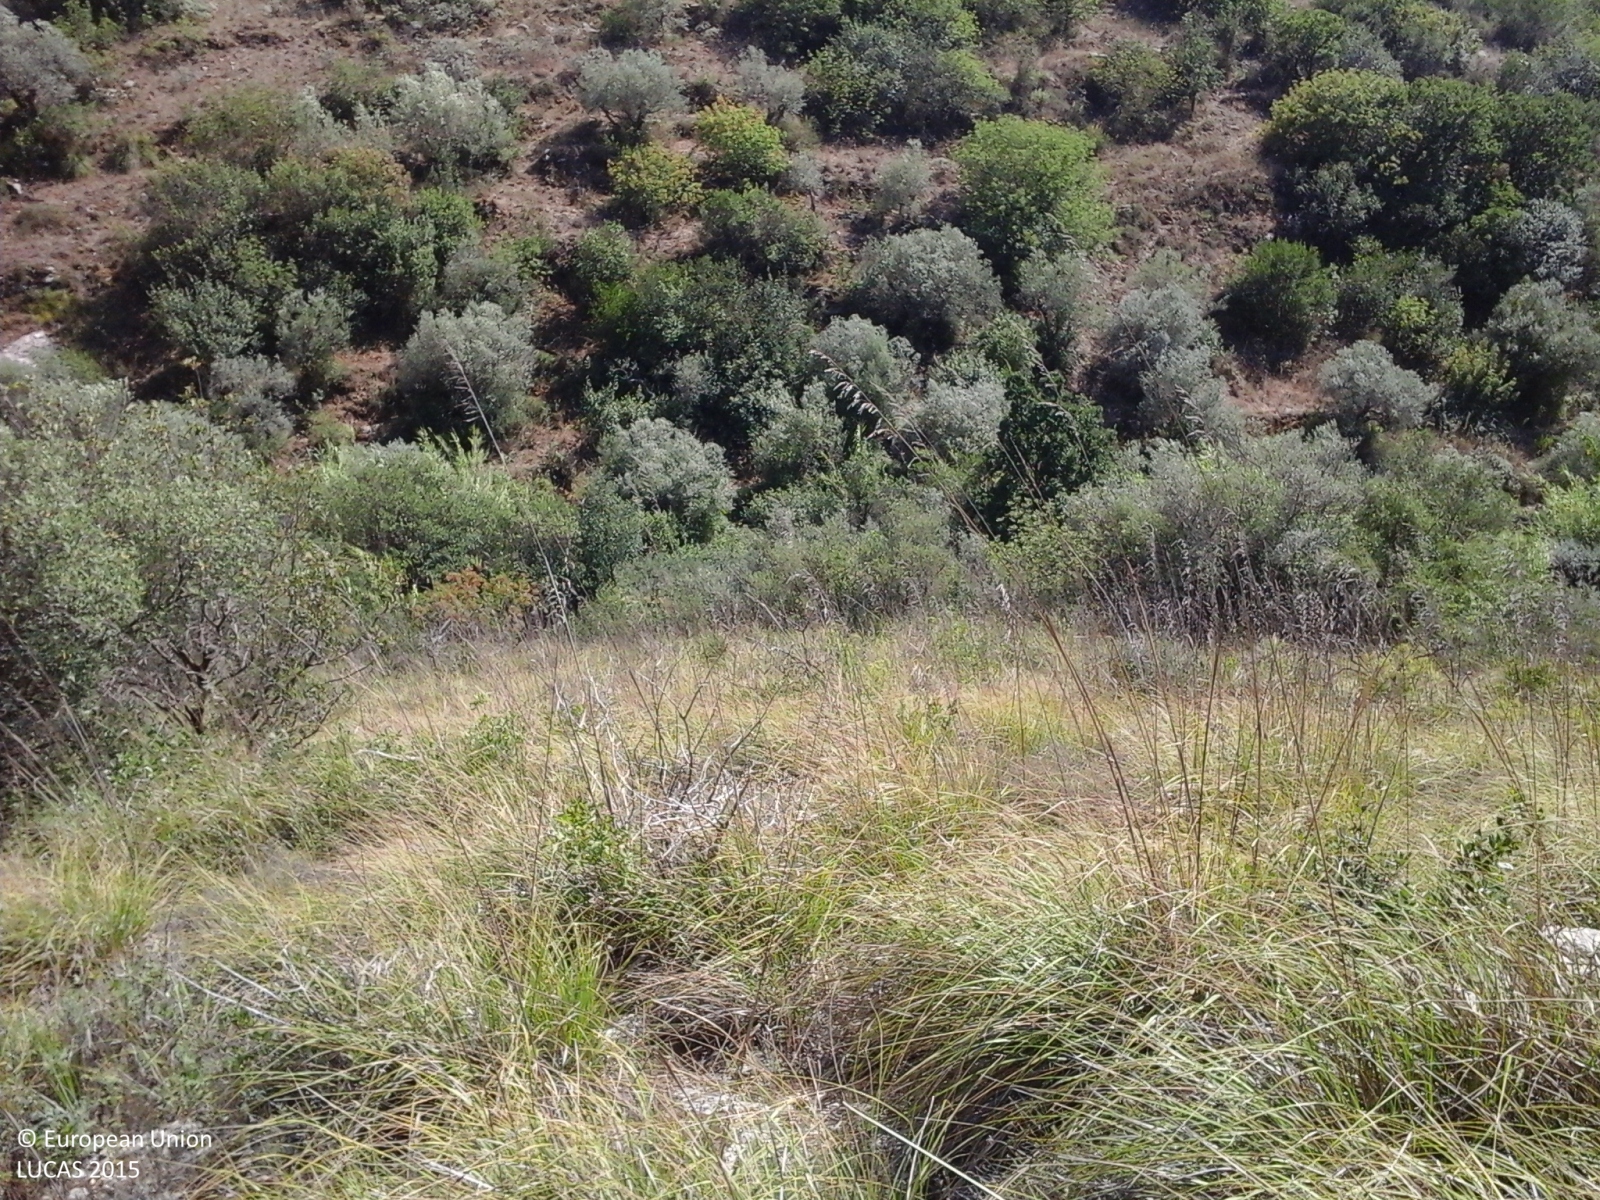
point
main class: Shrubland
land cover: Shrubland with sparse tree cover
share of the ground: > 75 %
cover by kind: shrubs 90 %, coniferous forest trees 5 %, herbaceous plants 5 %
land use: Semi-natural and natural areas not in use
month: July
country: IT
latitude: 37.1492
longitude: 14.8829
